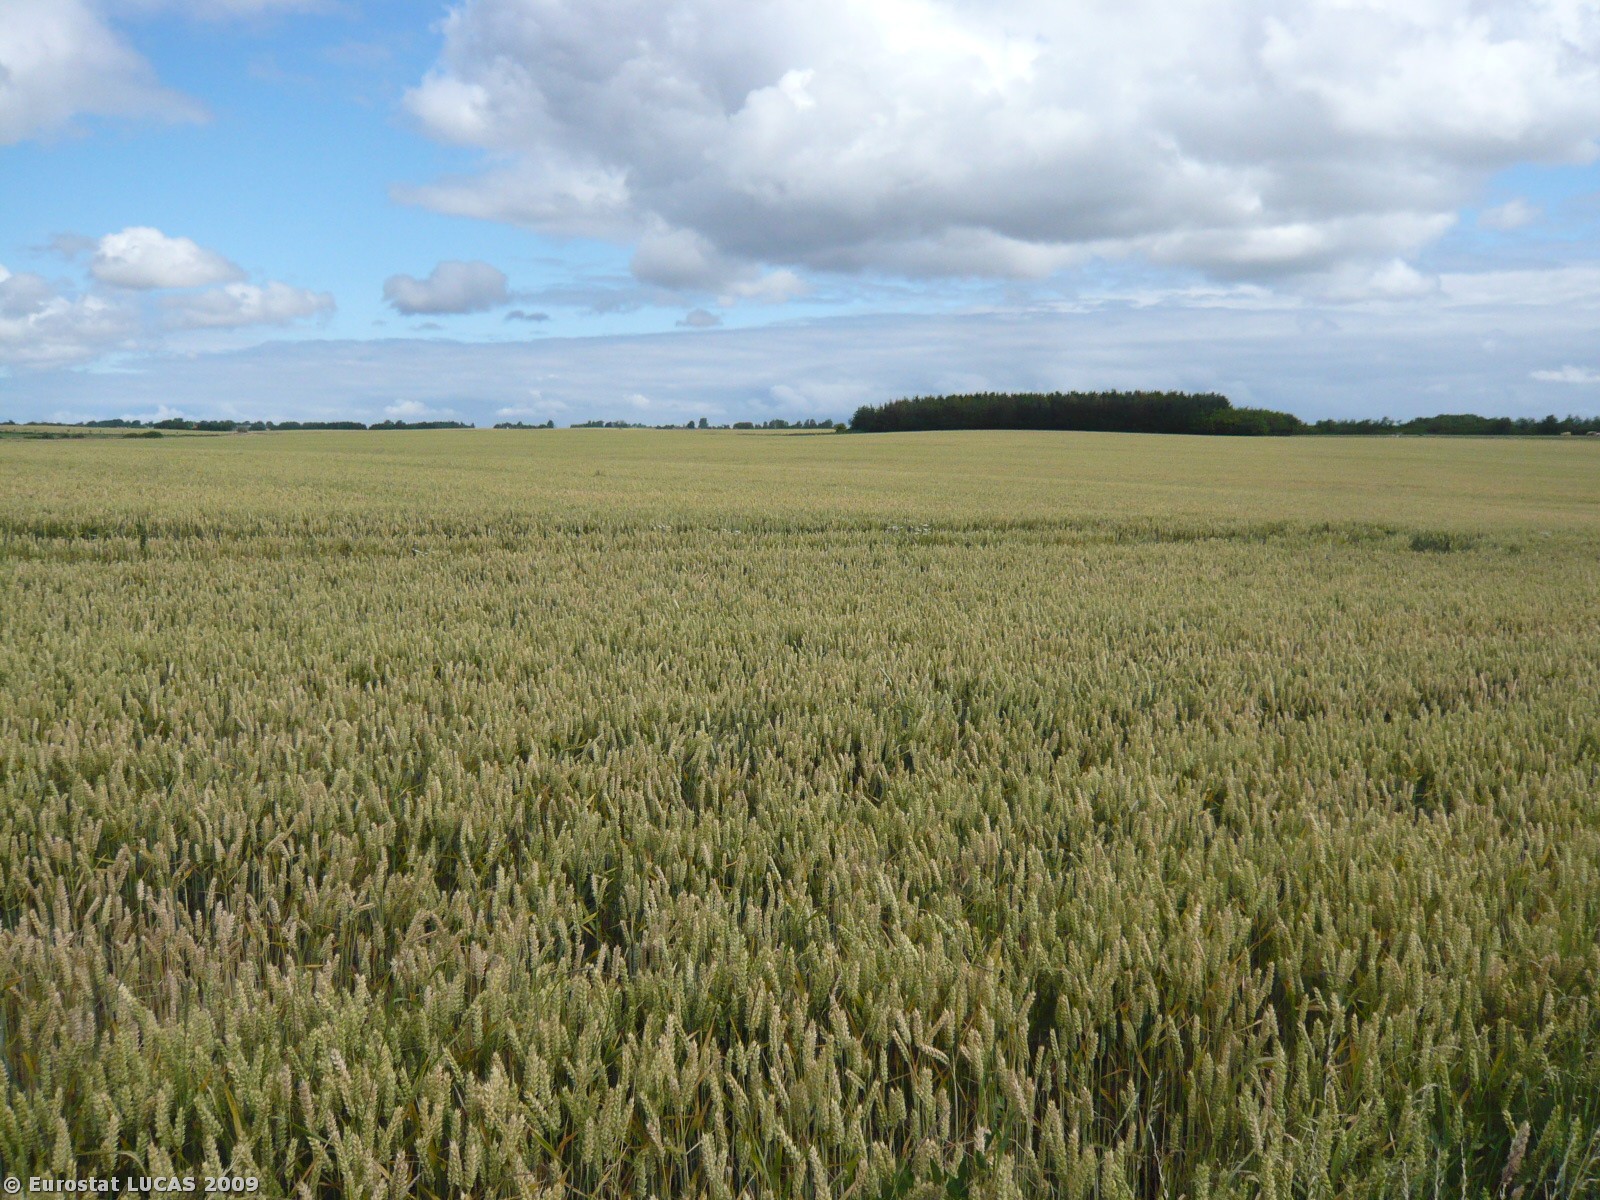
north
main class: Cropland
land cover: Common wheat
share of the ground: > 75 %
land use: Agriculture (excluding fallow land and kitchen gardens)
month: July
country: DK
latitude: 55.5884
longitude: 11.2523
